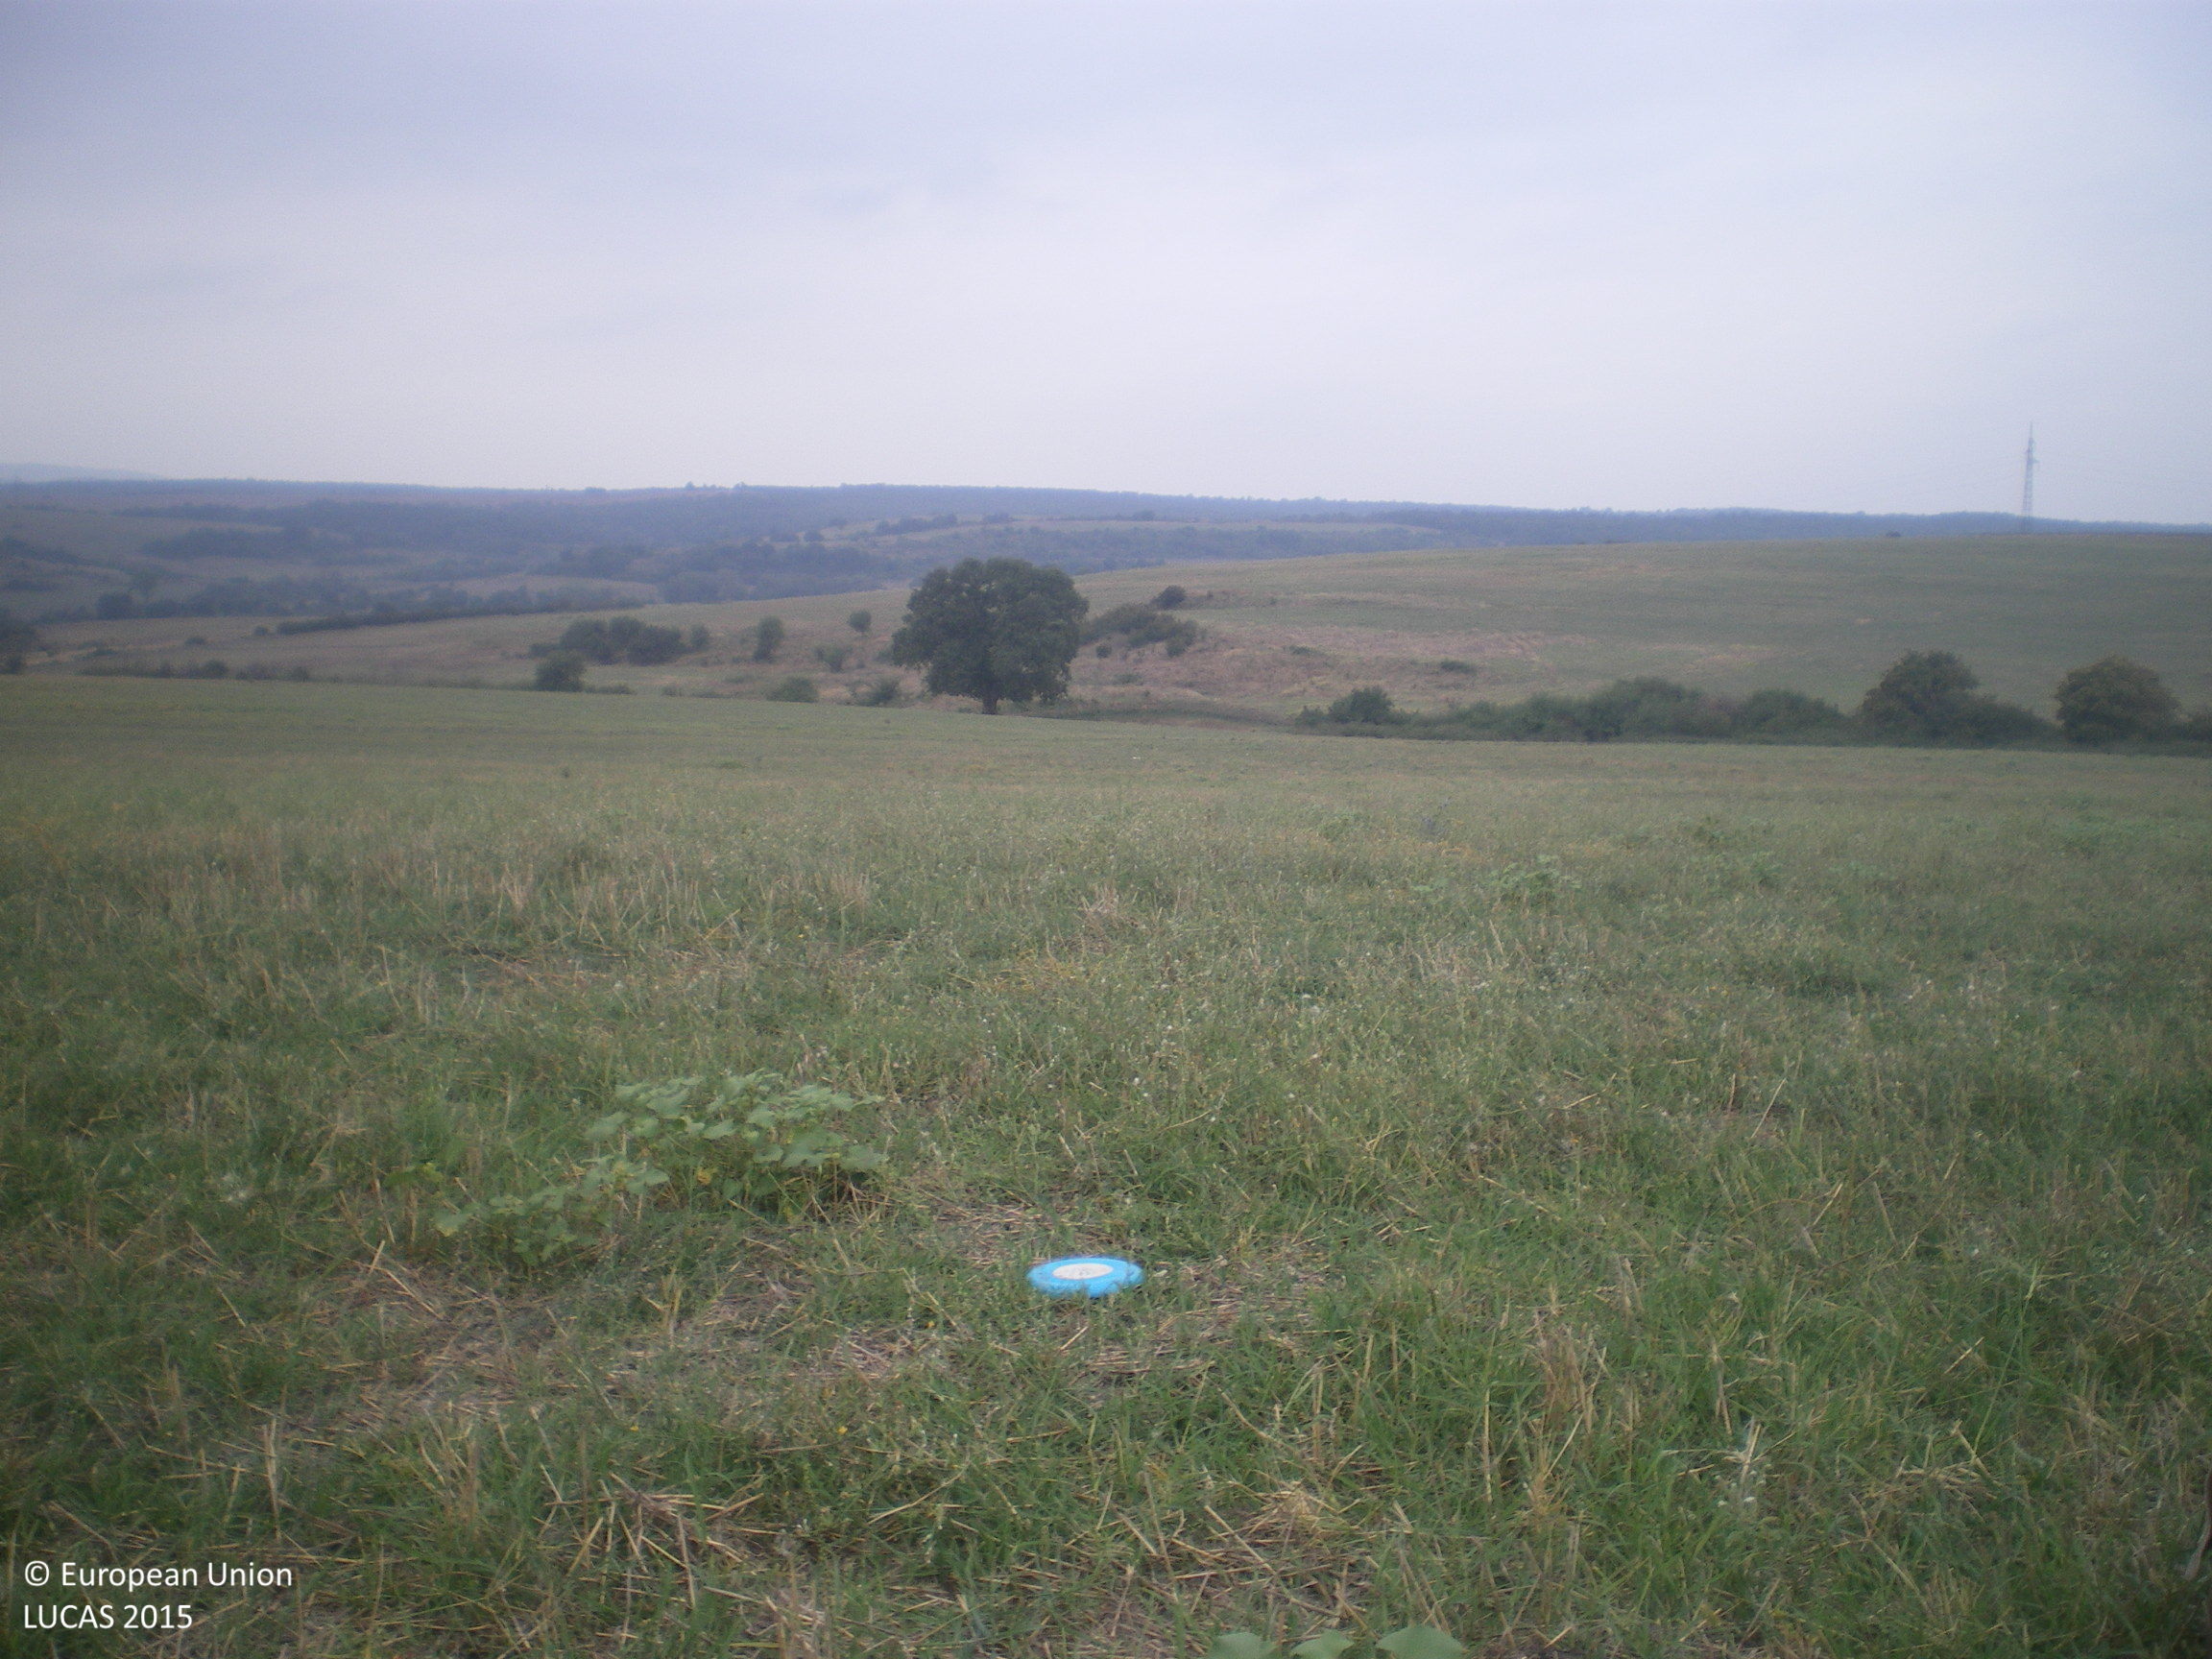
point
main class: Cropland
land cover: Barley
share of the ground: < 10 %
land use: Agriculture (excluding fallow land and kitchen gardens)
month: September
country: BG
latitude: 42.0456
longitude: 25.8131
